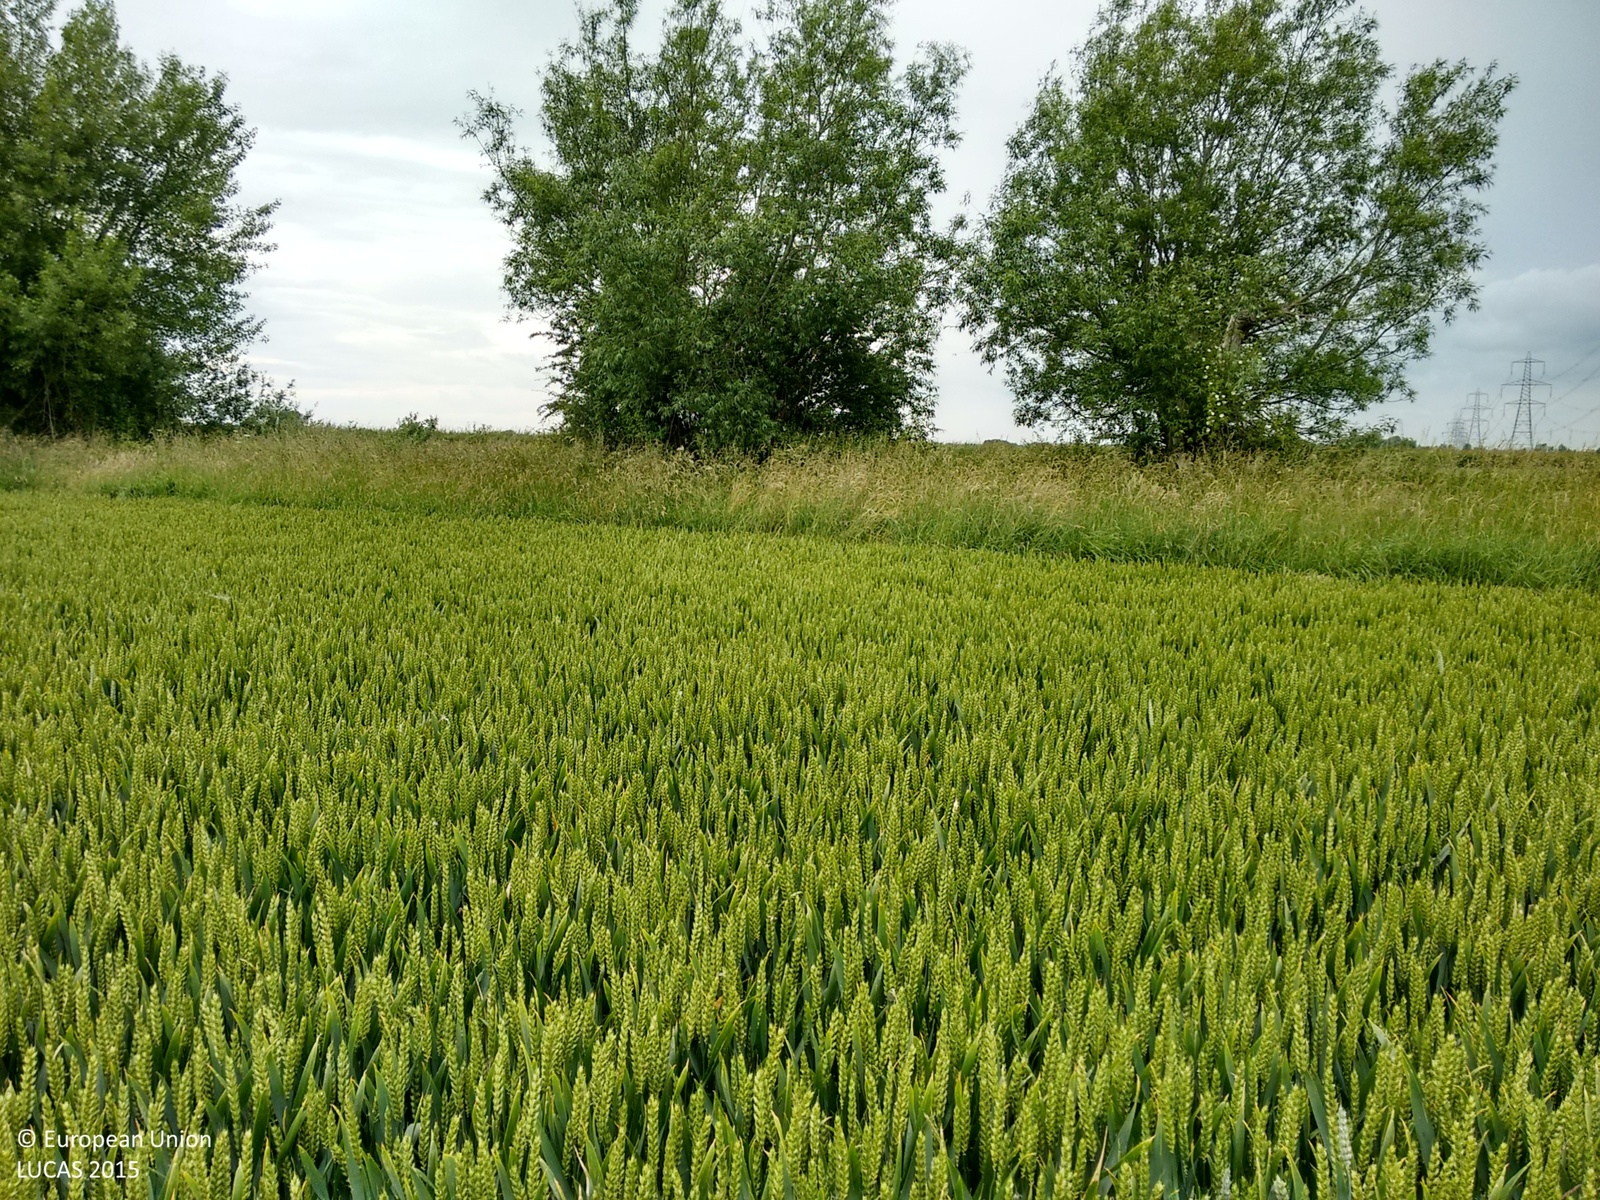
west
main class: Cropland
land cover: Common wheat
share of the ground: > 75 %
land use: Agriculture (excluding fallow land and kitchen gardens)
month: June
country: GB
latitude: 51.6963
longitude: -1.6126
